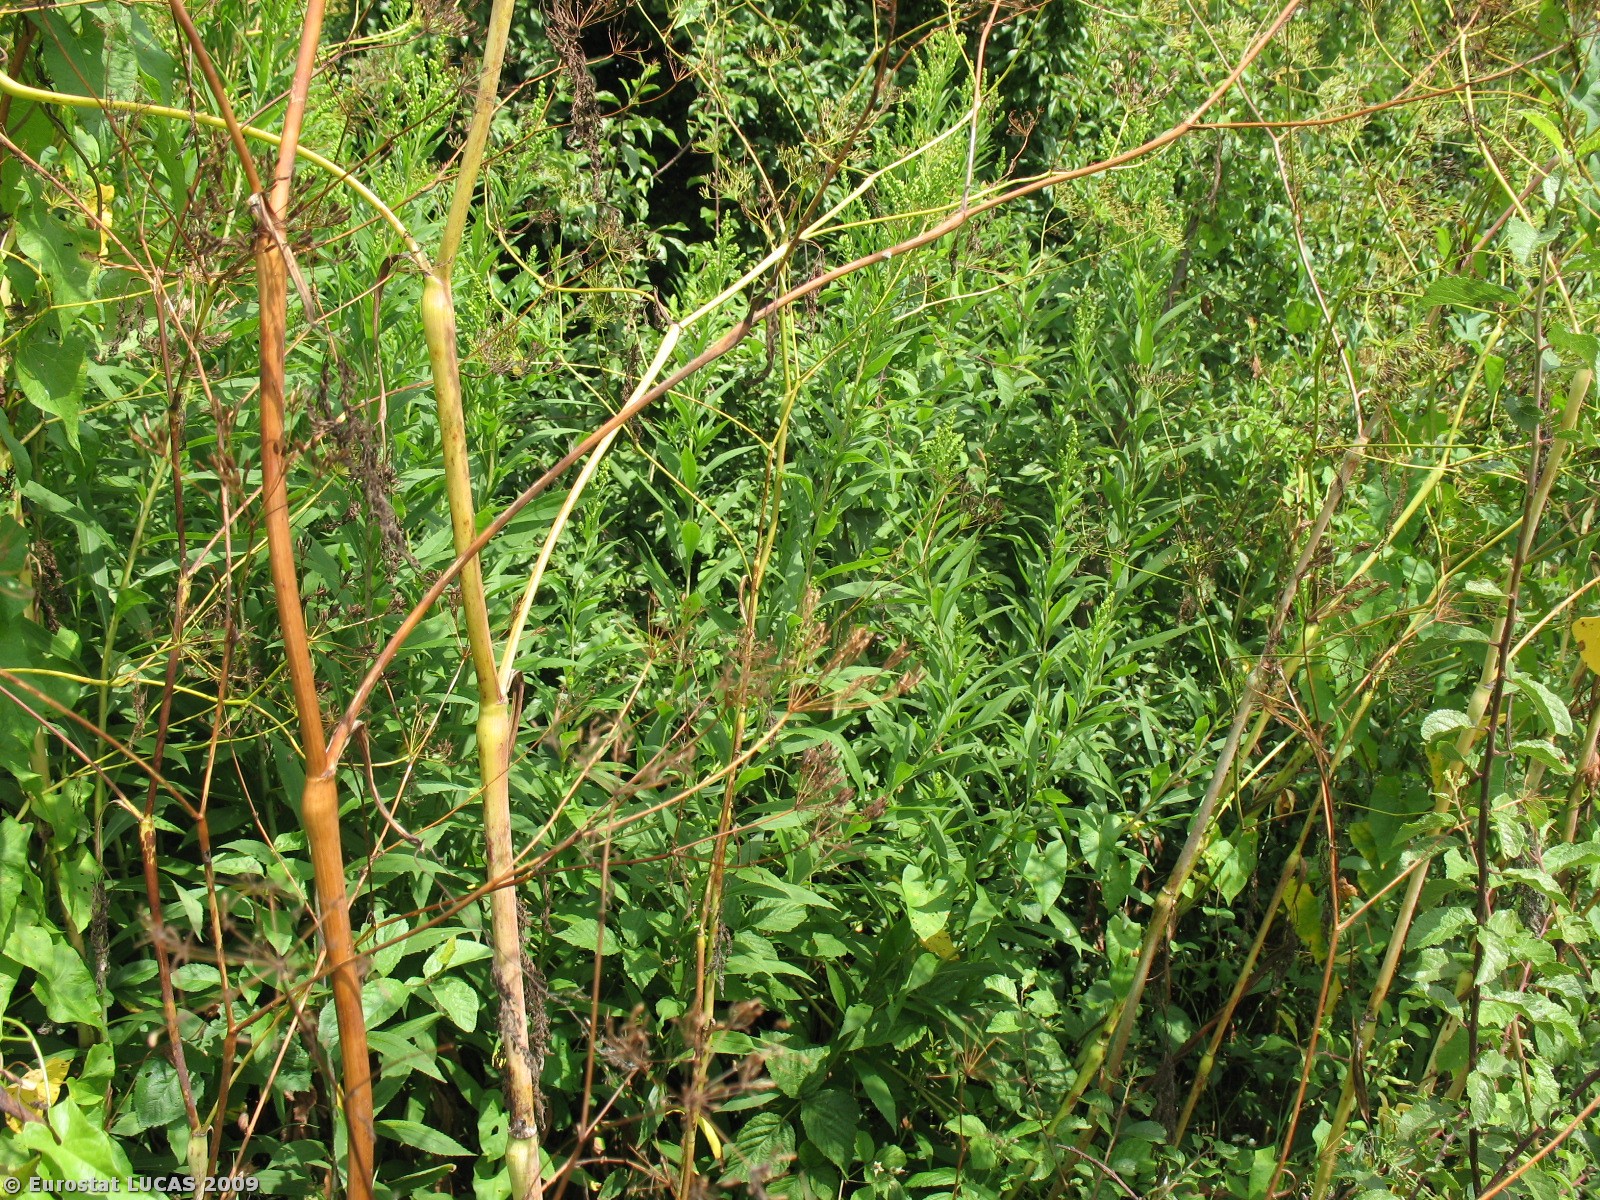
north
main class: Shrubland
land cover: Shrubland without tree cover
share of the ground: > 75 %
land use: Unused
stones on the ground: < 10 %
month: July
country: PL
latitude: 50.2390
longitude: 22.5022
